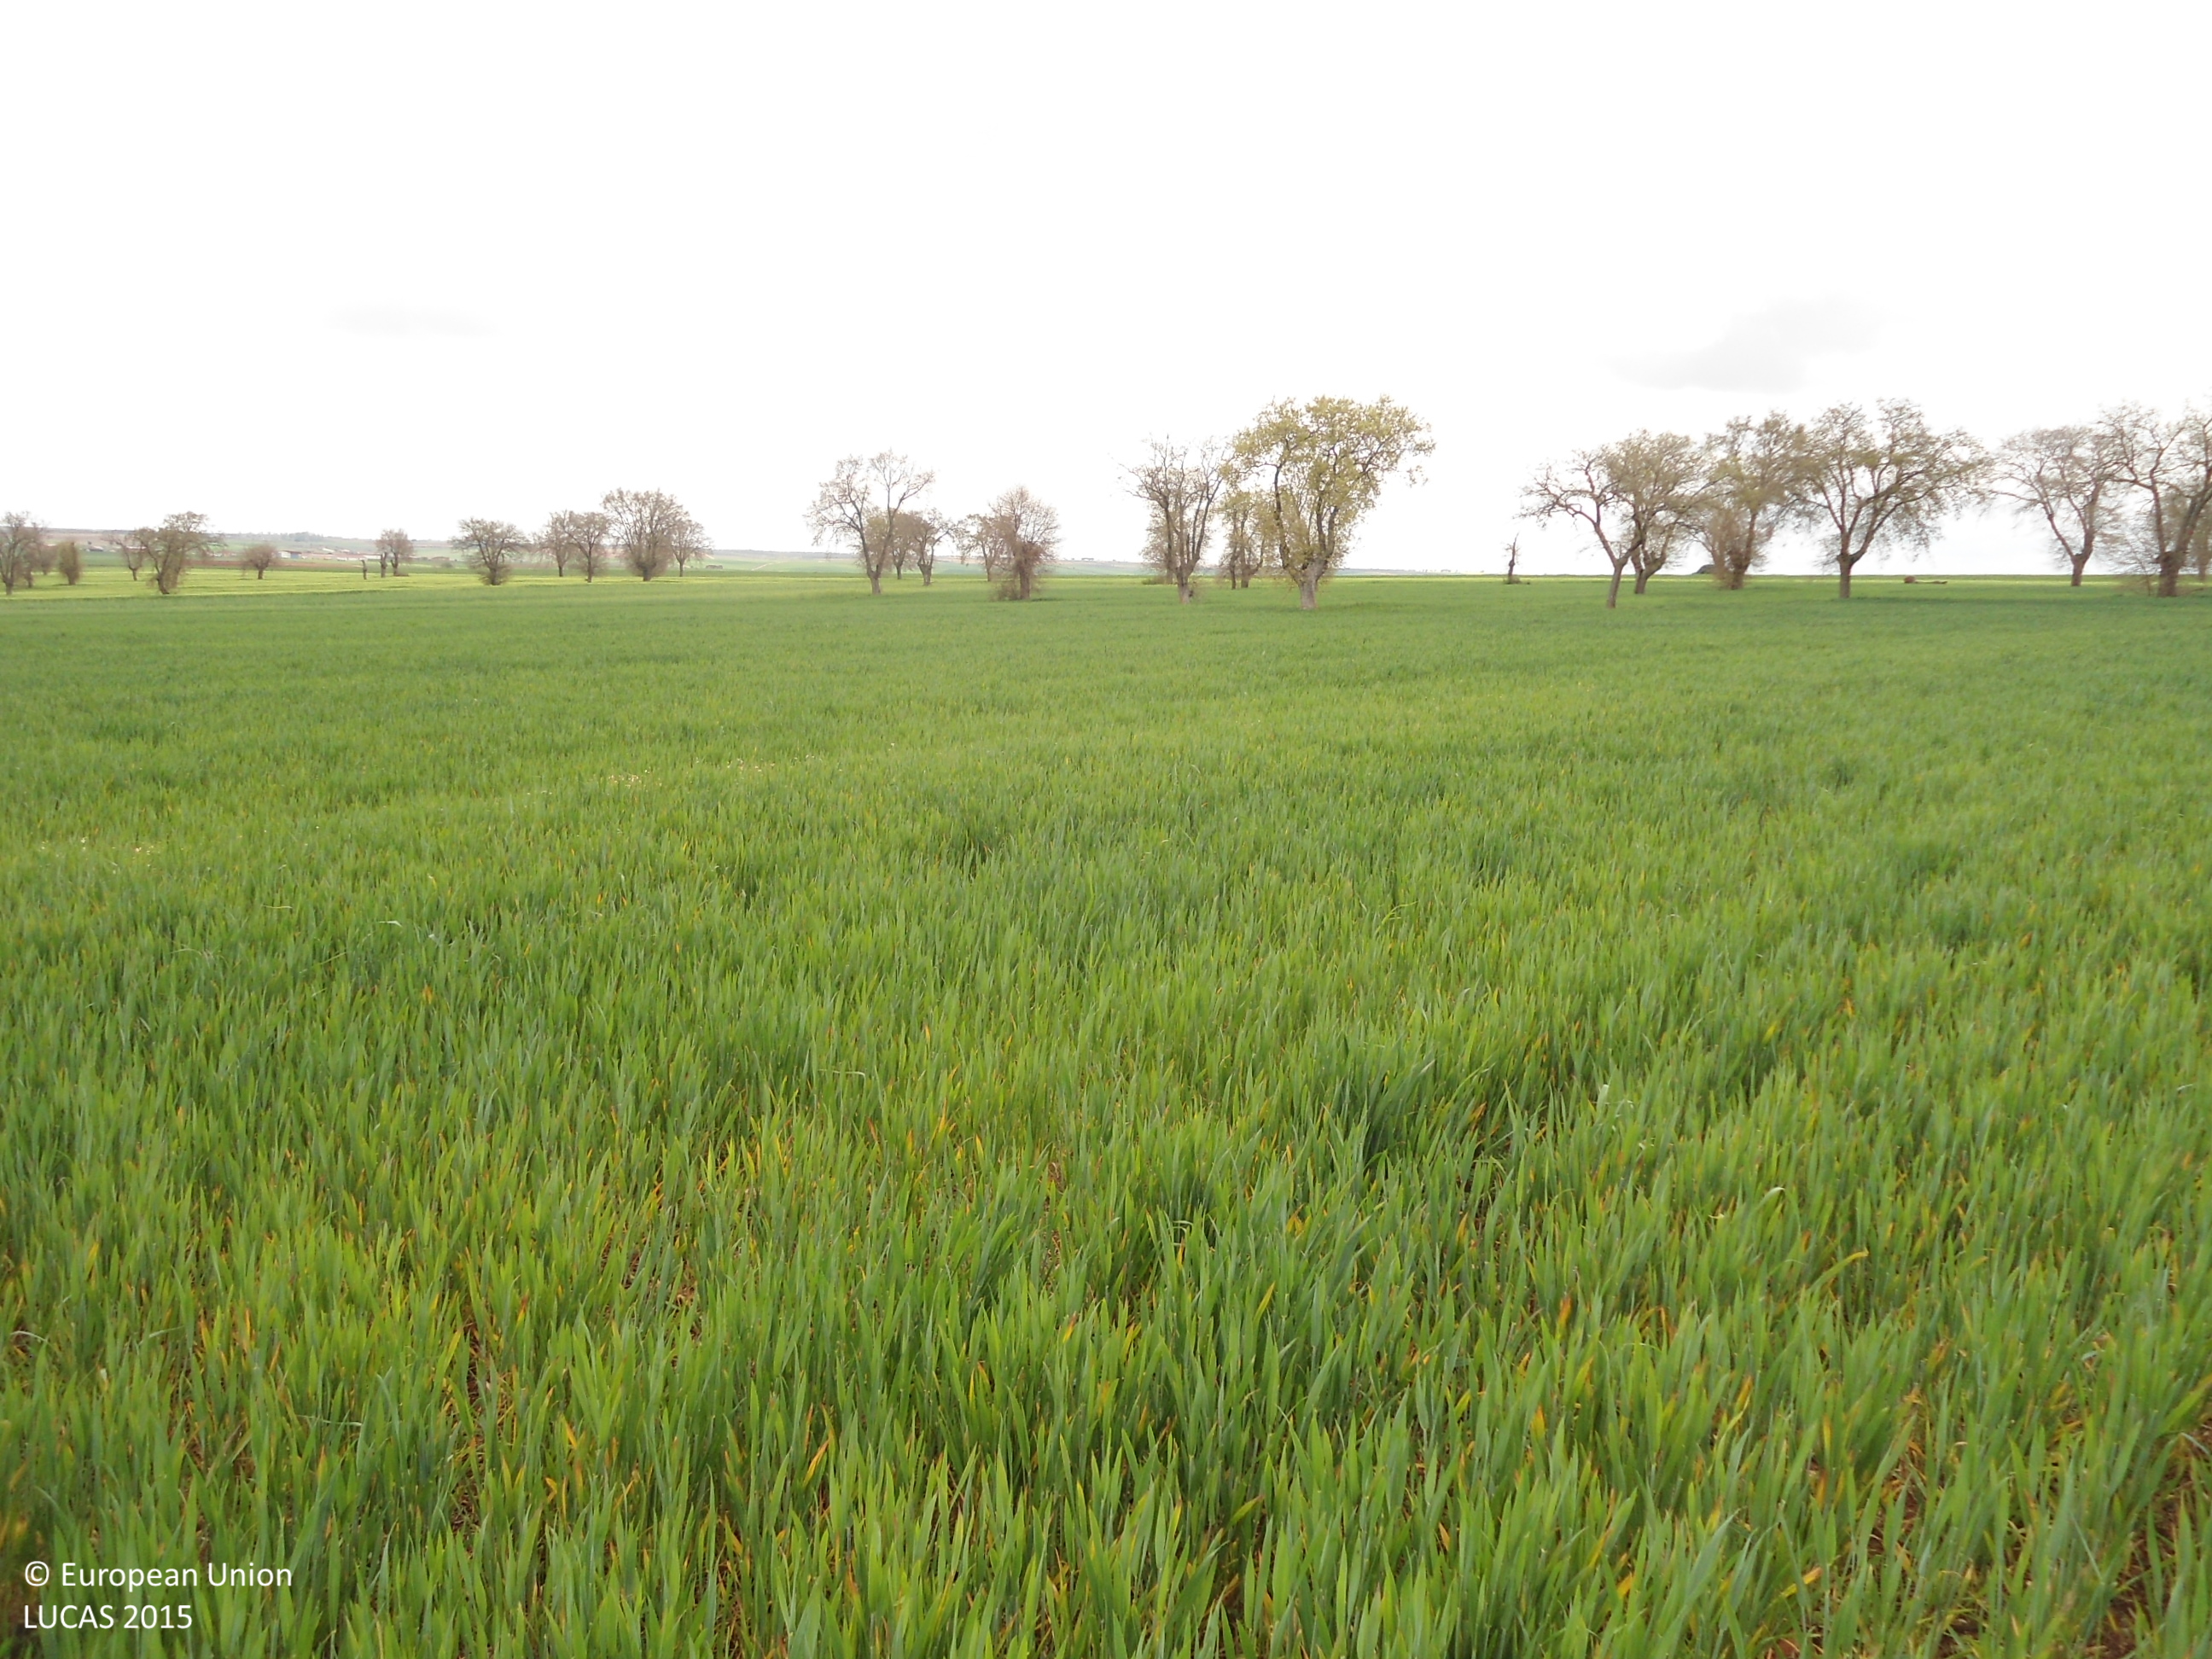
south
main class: Cropland
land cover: Common wheat
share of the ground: > 75 %
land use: Agriculture (excluding fallow land and kitchen gardens)
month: April
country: ES
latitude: 41.6138
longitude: -5.8712
